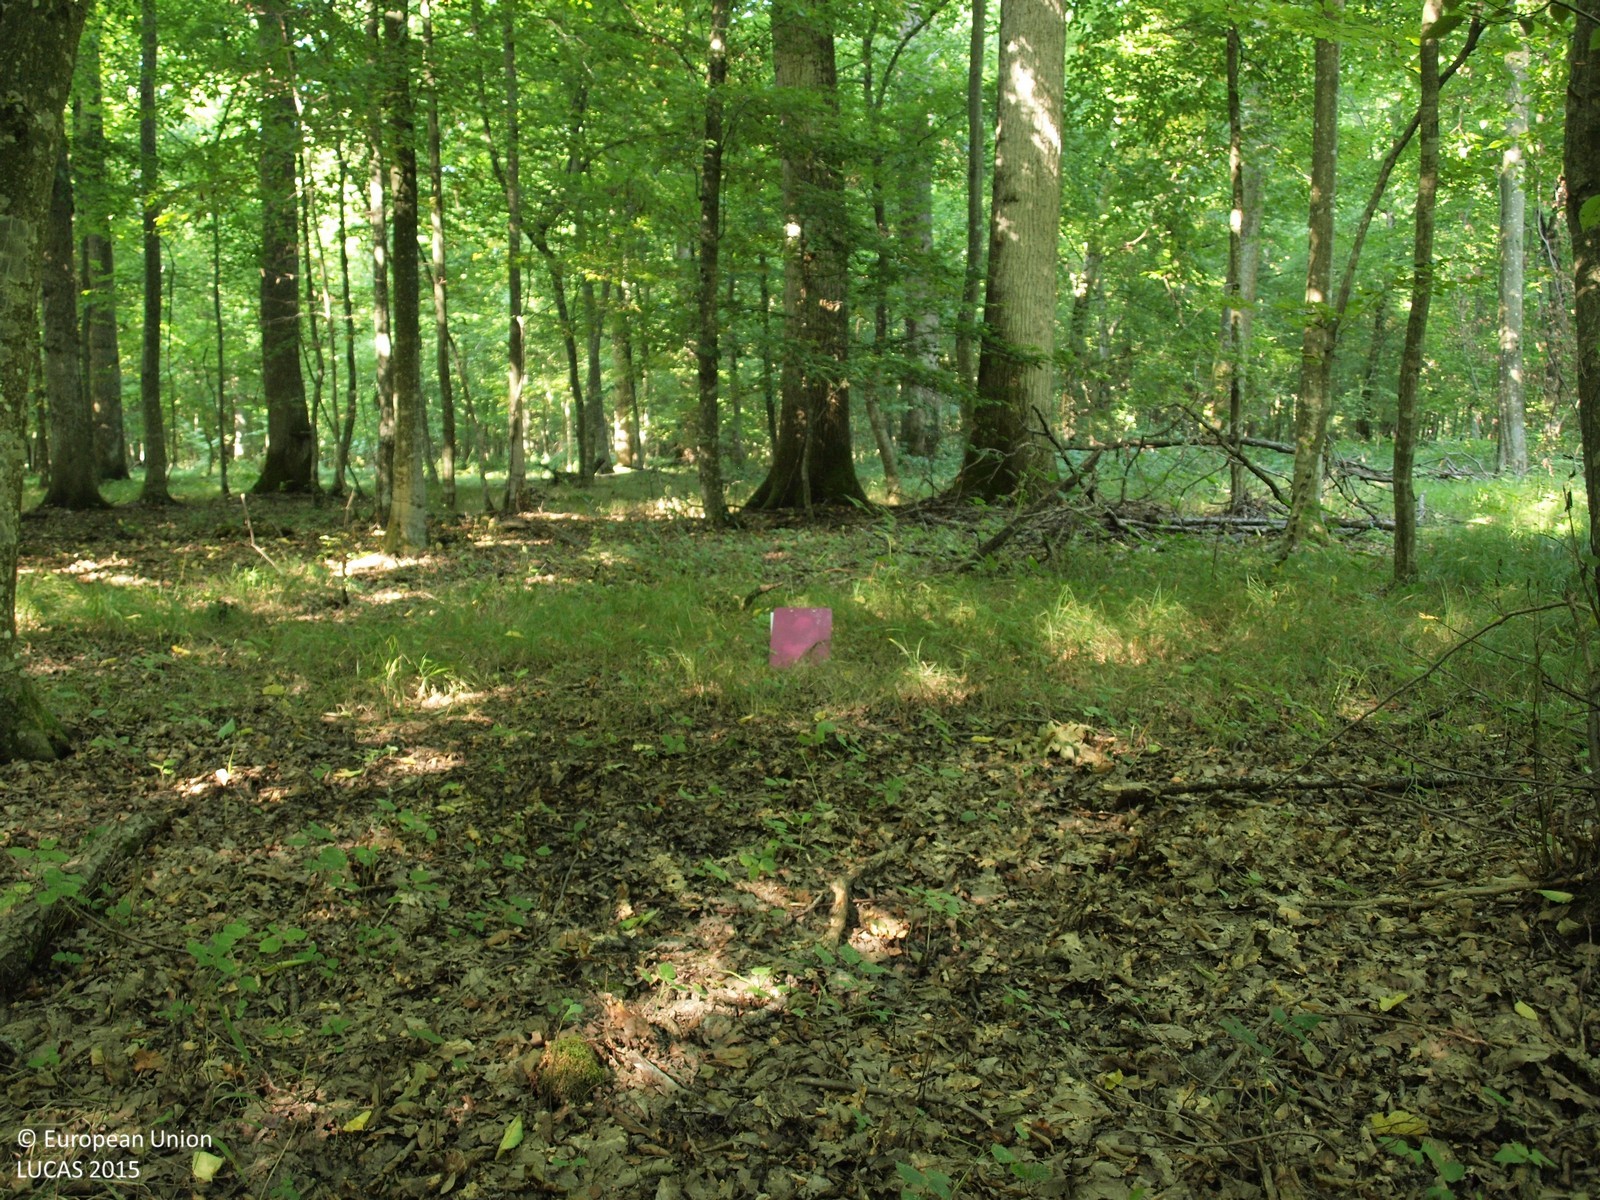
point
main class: Woodland
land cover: Broadleaved woodland
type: mesophytic deciduous forest
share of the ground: > 75 %
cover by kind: broadleaved forest trees 100 %
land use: Forestry
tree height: > 5 m
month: August
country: HR
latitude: 45.8904
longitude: 16.6624
